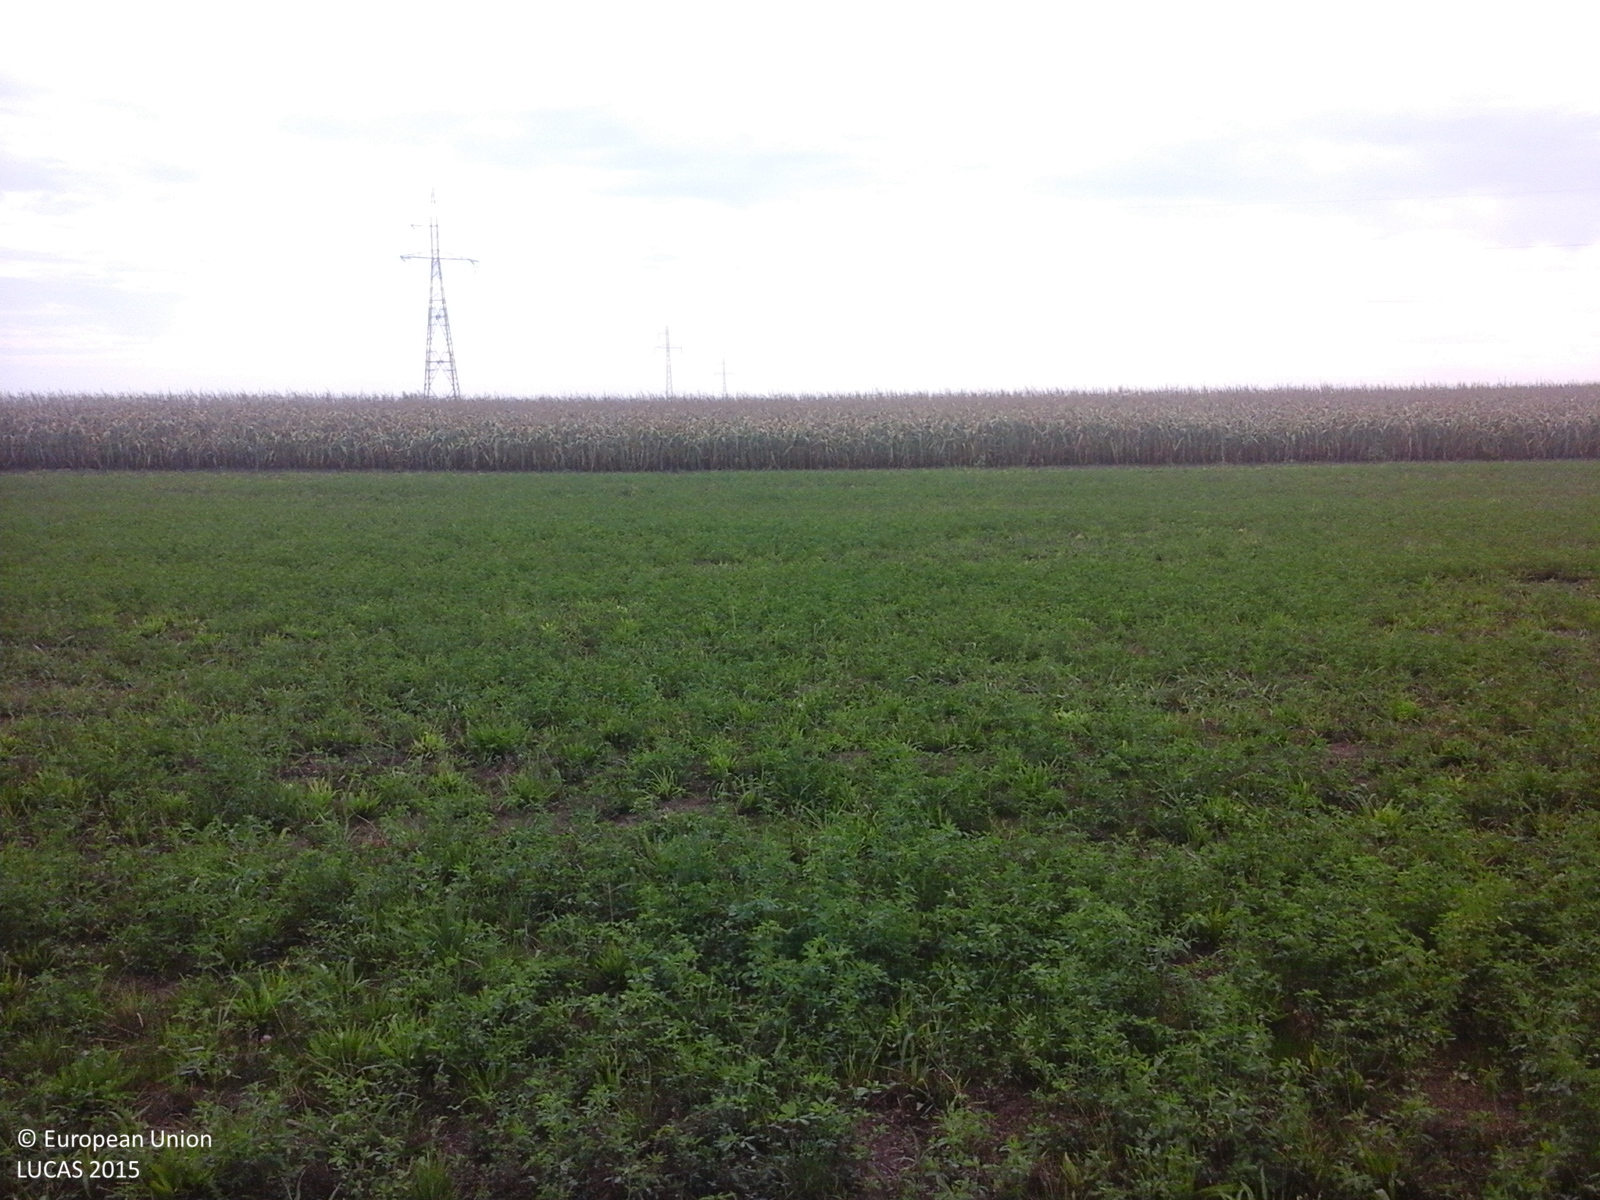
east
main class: Cropland
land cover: Lucerne
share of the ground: > 75 %
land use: Agriculture (excluding fallow land and kitchen gardens)
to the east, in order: Lucerne; Maize; Electric lines; Maize; Other bare soil
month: August
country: RO
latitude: 46.1057
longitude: 20.8567
